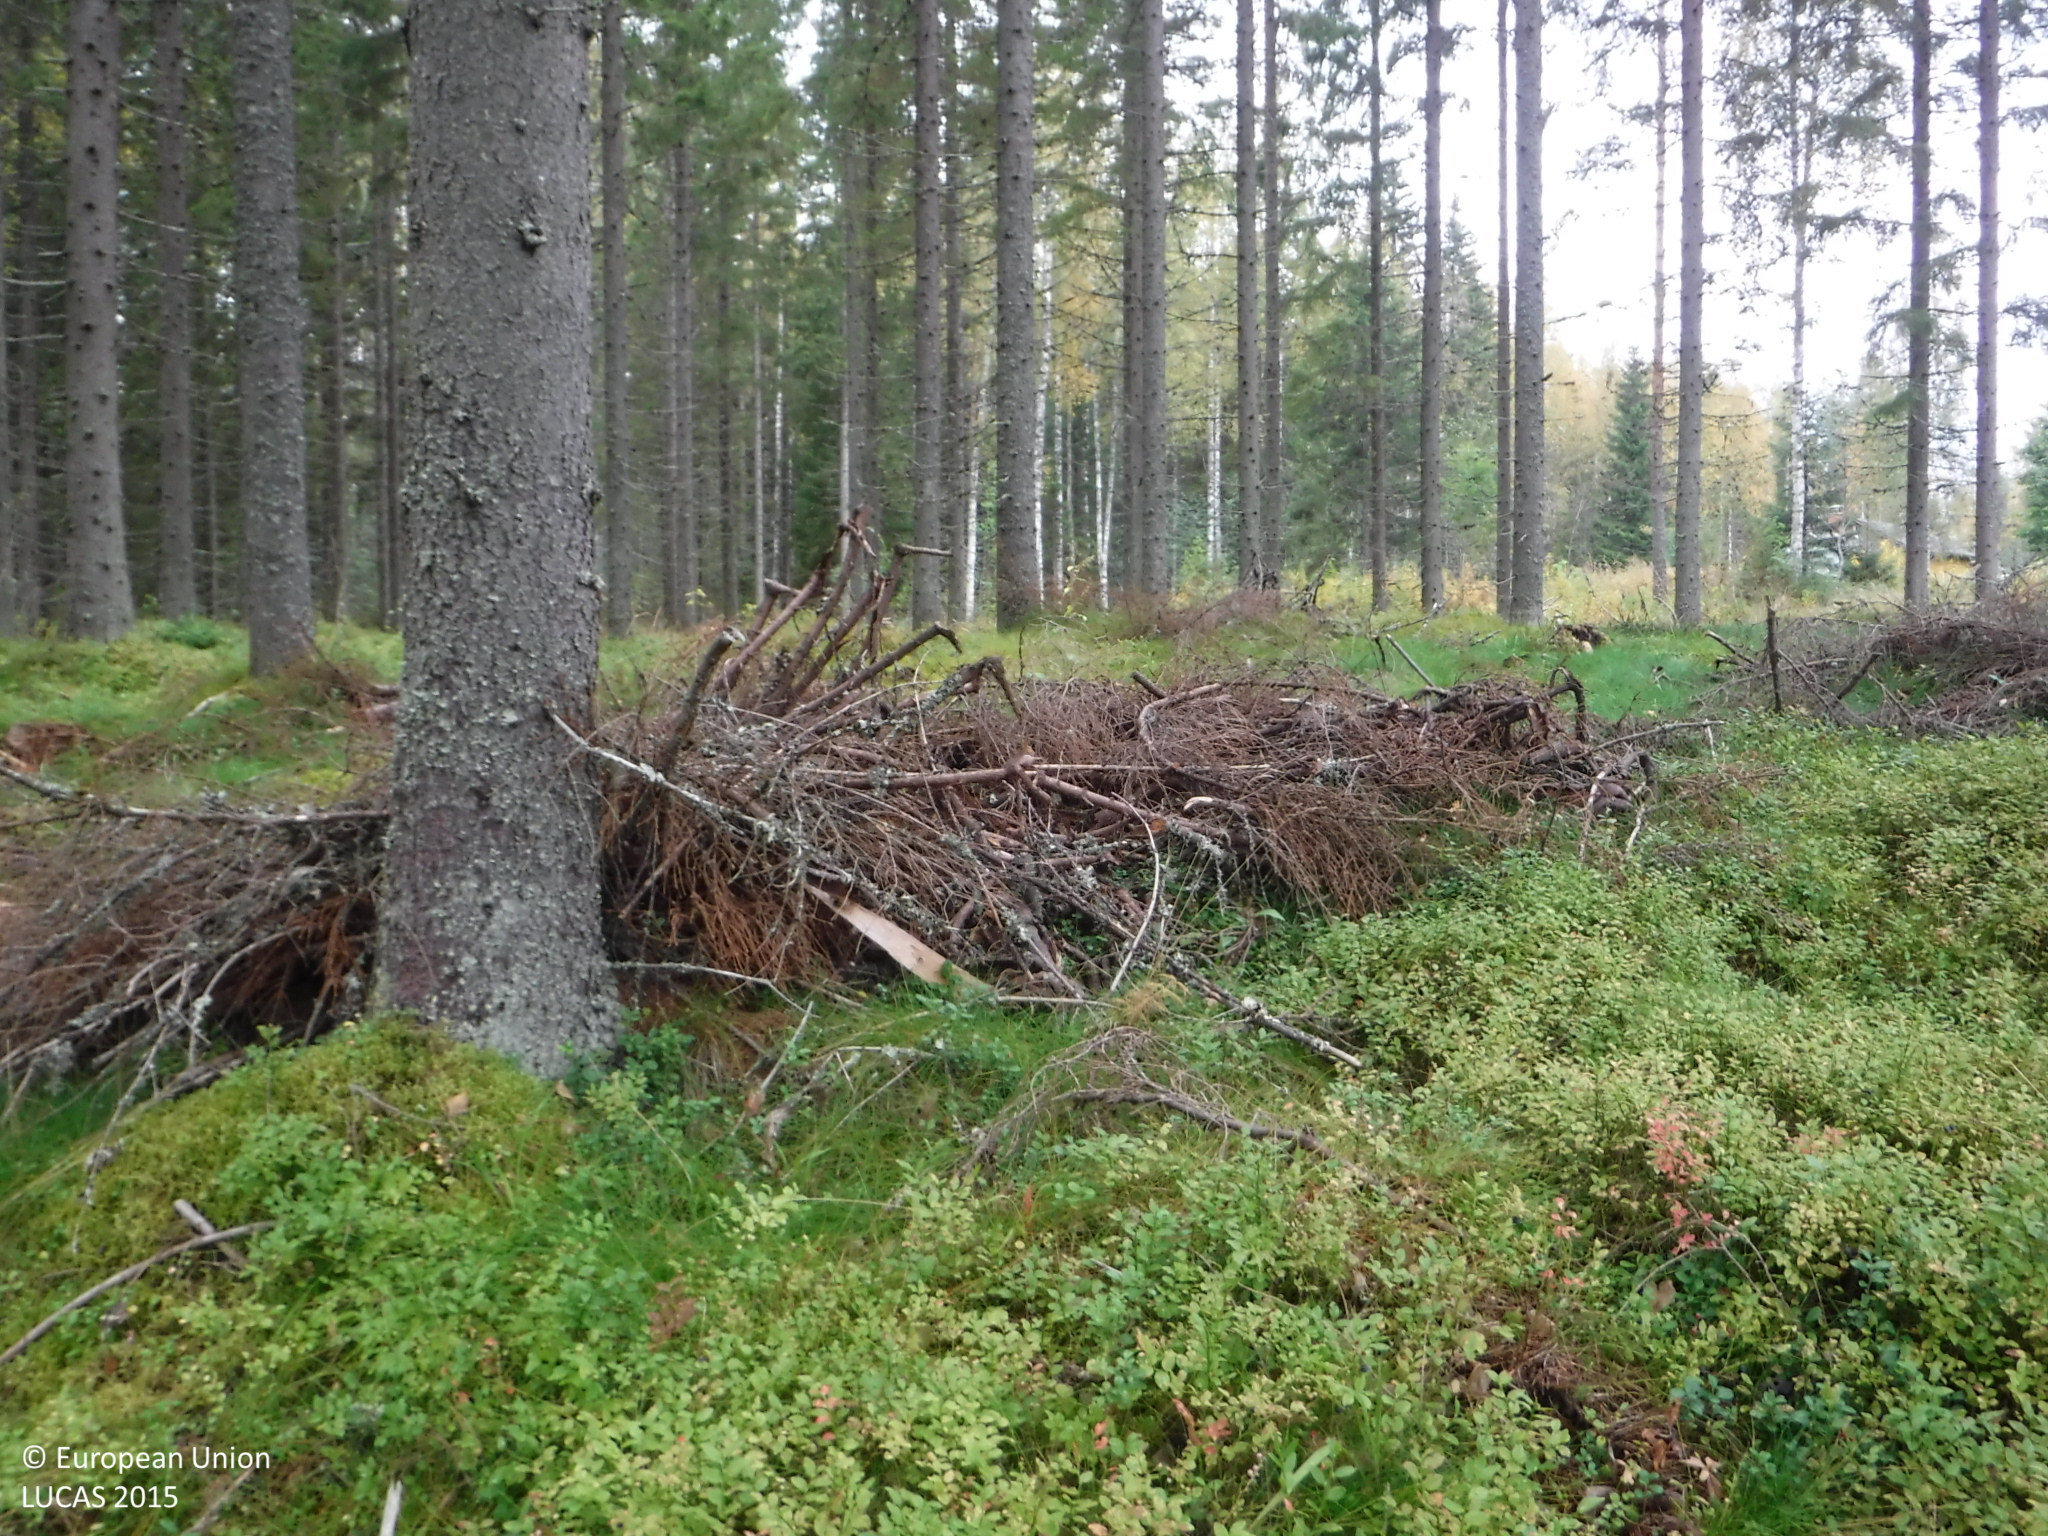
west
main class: Woodland
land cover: Spruce dominated coniferous woodland
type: boreal forest
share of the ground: 50 - 75 %
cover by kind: coniferous forest trees 70 %, shrubs 15 %, lichens and mosses 15 %
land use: Forestry
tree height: > 5 m
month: September
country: FI
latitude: 62.1237
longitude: 23.3578
